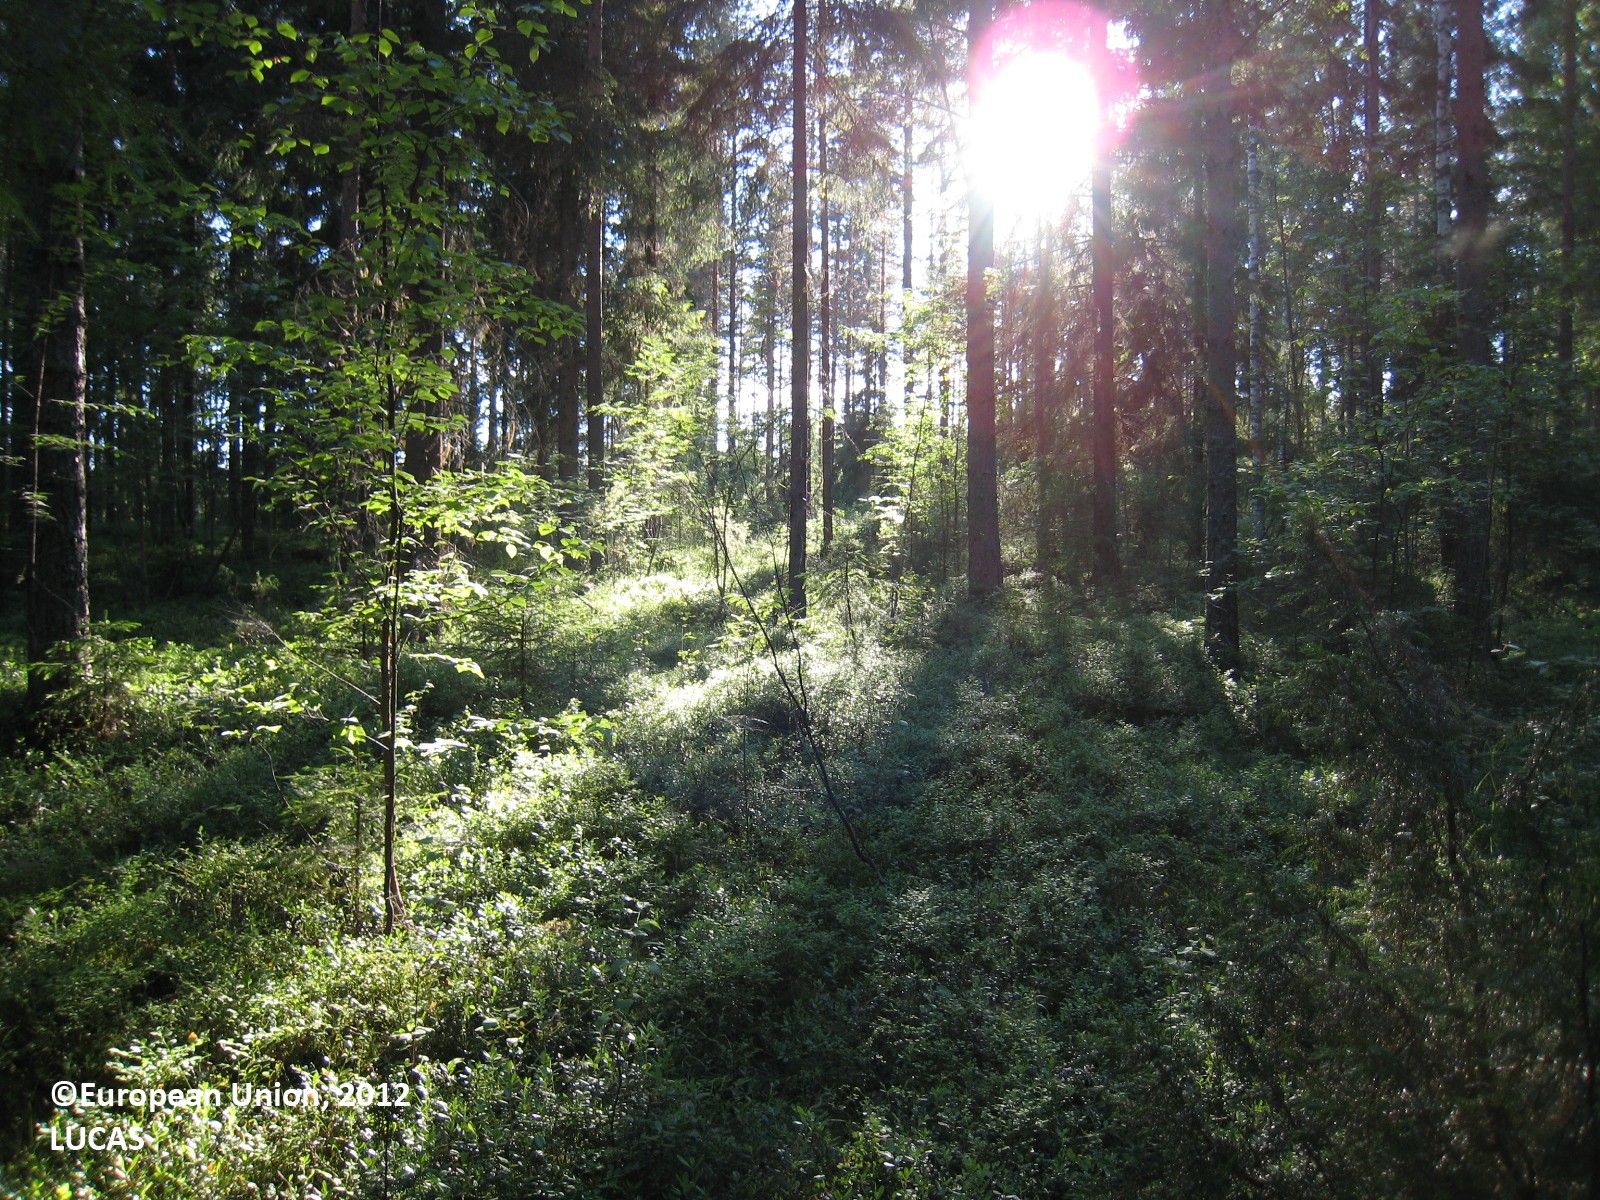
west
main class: Woodland
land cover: Other coniferous woodland
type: boreal forest
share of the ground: 50 - 75 %
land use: Forestry
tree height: > 5 m
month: June
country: FI
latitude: 62.3793
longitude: 26.4758
